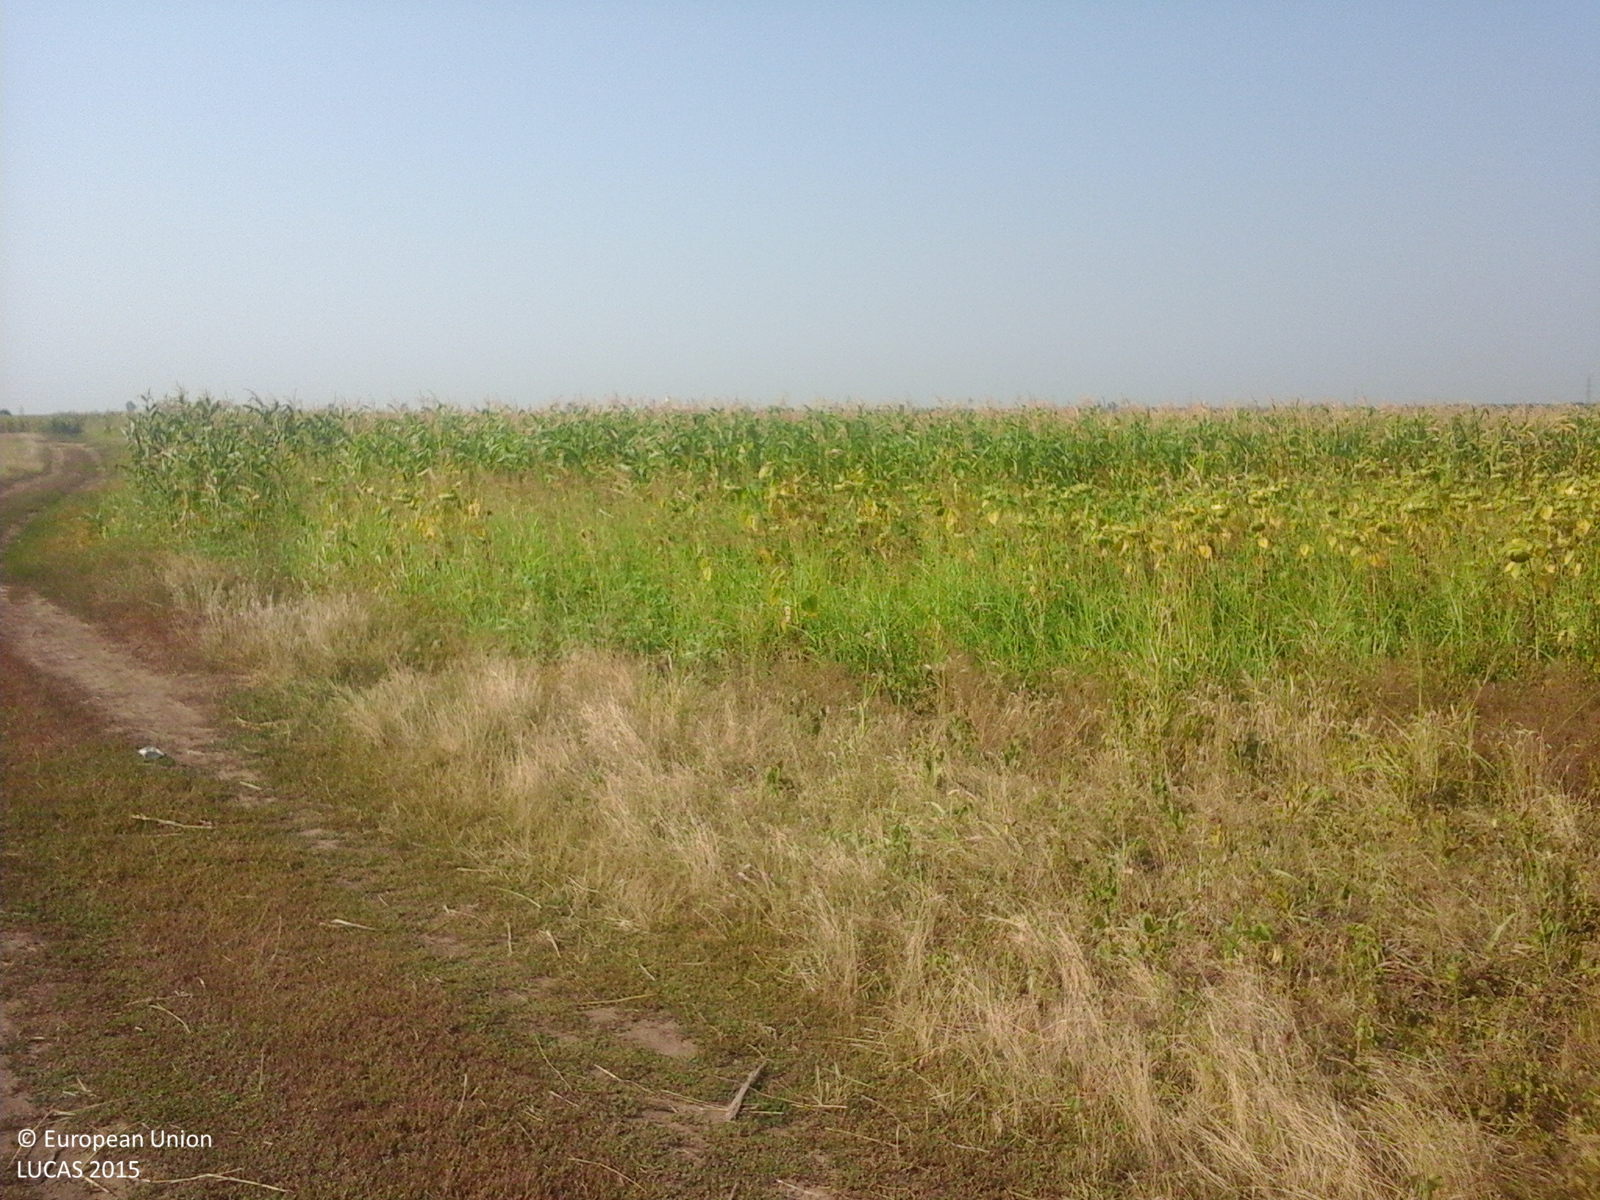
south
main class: Cropland
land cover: Common wheat
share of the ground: > 75 %
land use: Agriculture (excluding fallow land and kitchen gardens)
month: August
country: RO
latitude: 45.7119
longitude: 27.5637
